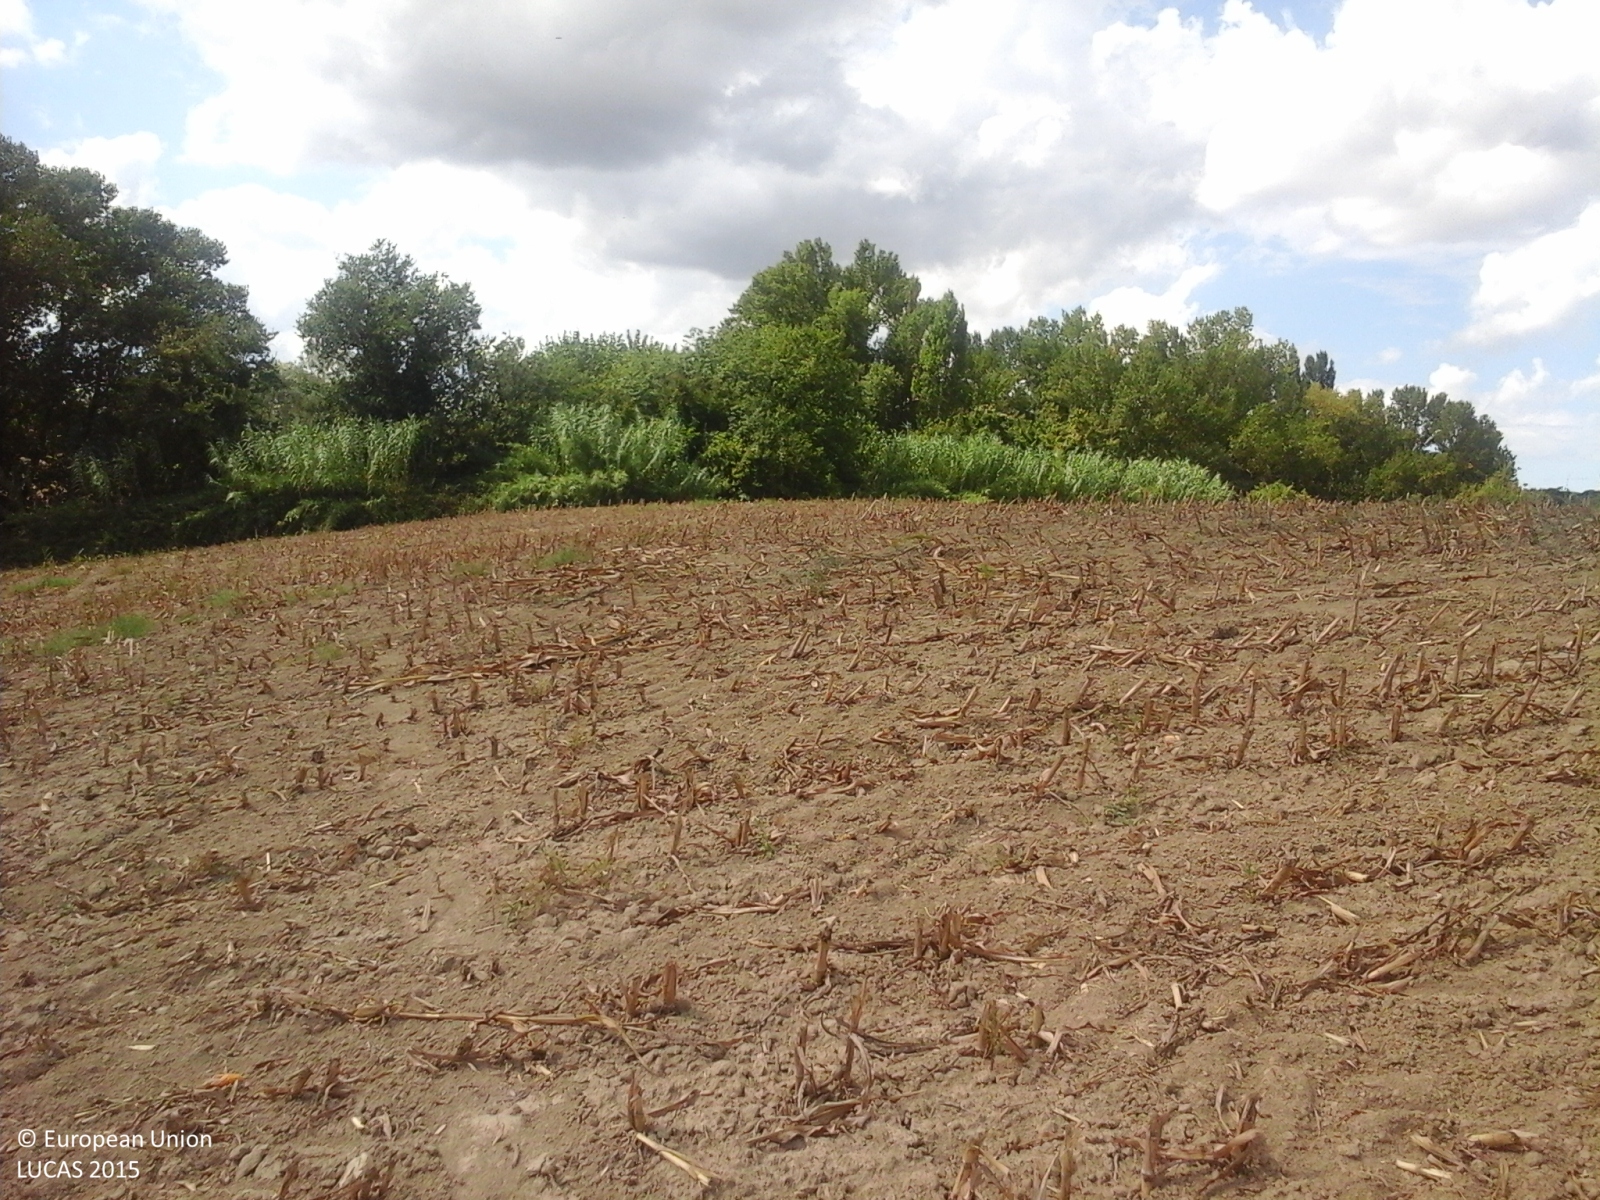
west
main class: Cropland
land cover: Maize
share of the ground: < 10 %
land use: Agriculture (excluding fallow land and kitchen gardens)
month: September
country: IT
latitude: 43.8410
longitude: 12.8912
